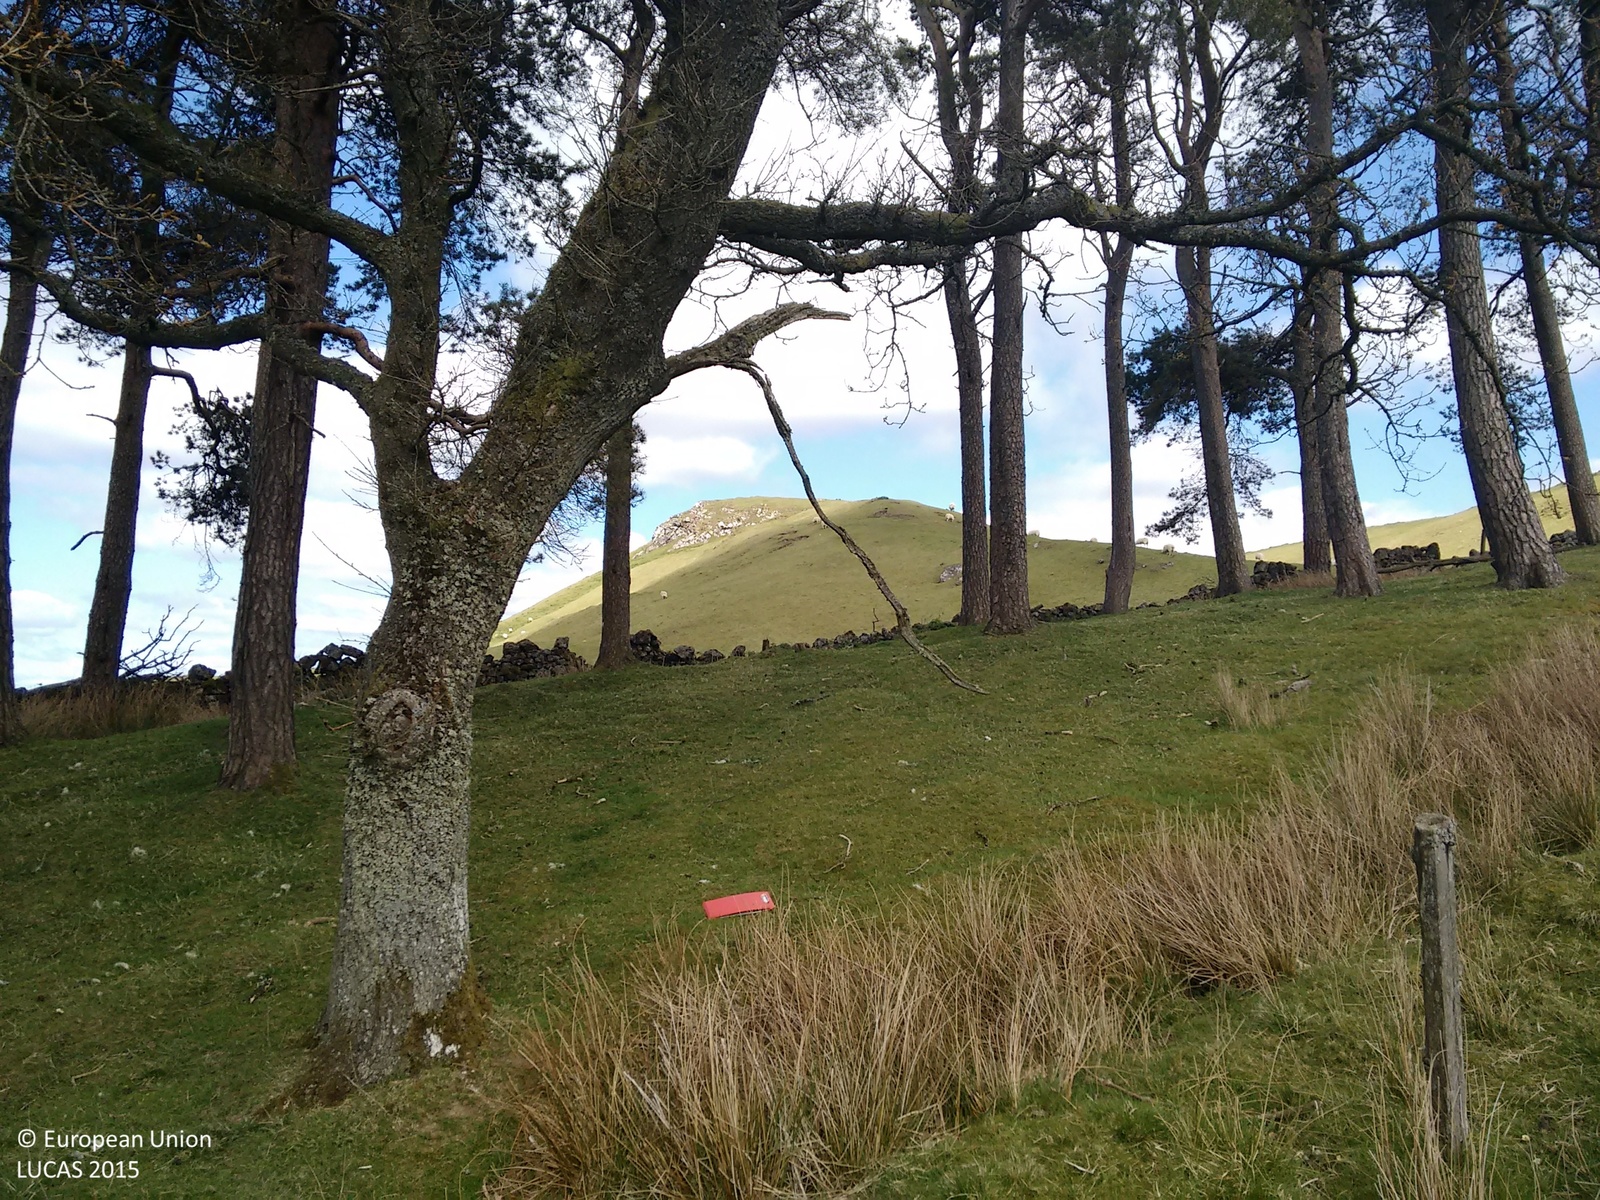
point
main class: Woodland
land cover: Pine dominated mixed woodland
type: hemiboreal forest and nemoral coniferous forest and mixed broadleaved-coniferous forest
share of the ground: > 75 %
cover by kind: coniferous forest trees 70 %, broadleaved forest trees 25 %, herbaceous plants 5 %
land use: Agriculture (excluding fallow land and kitchen gardens)
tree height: > 5 m
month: May
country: GB
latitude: 55.7279
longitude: -3.3064
